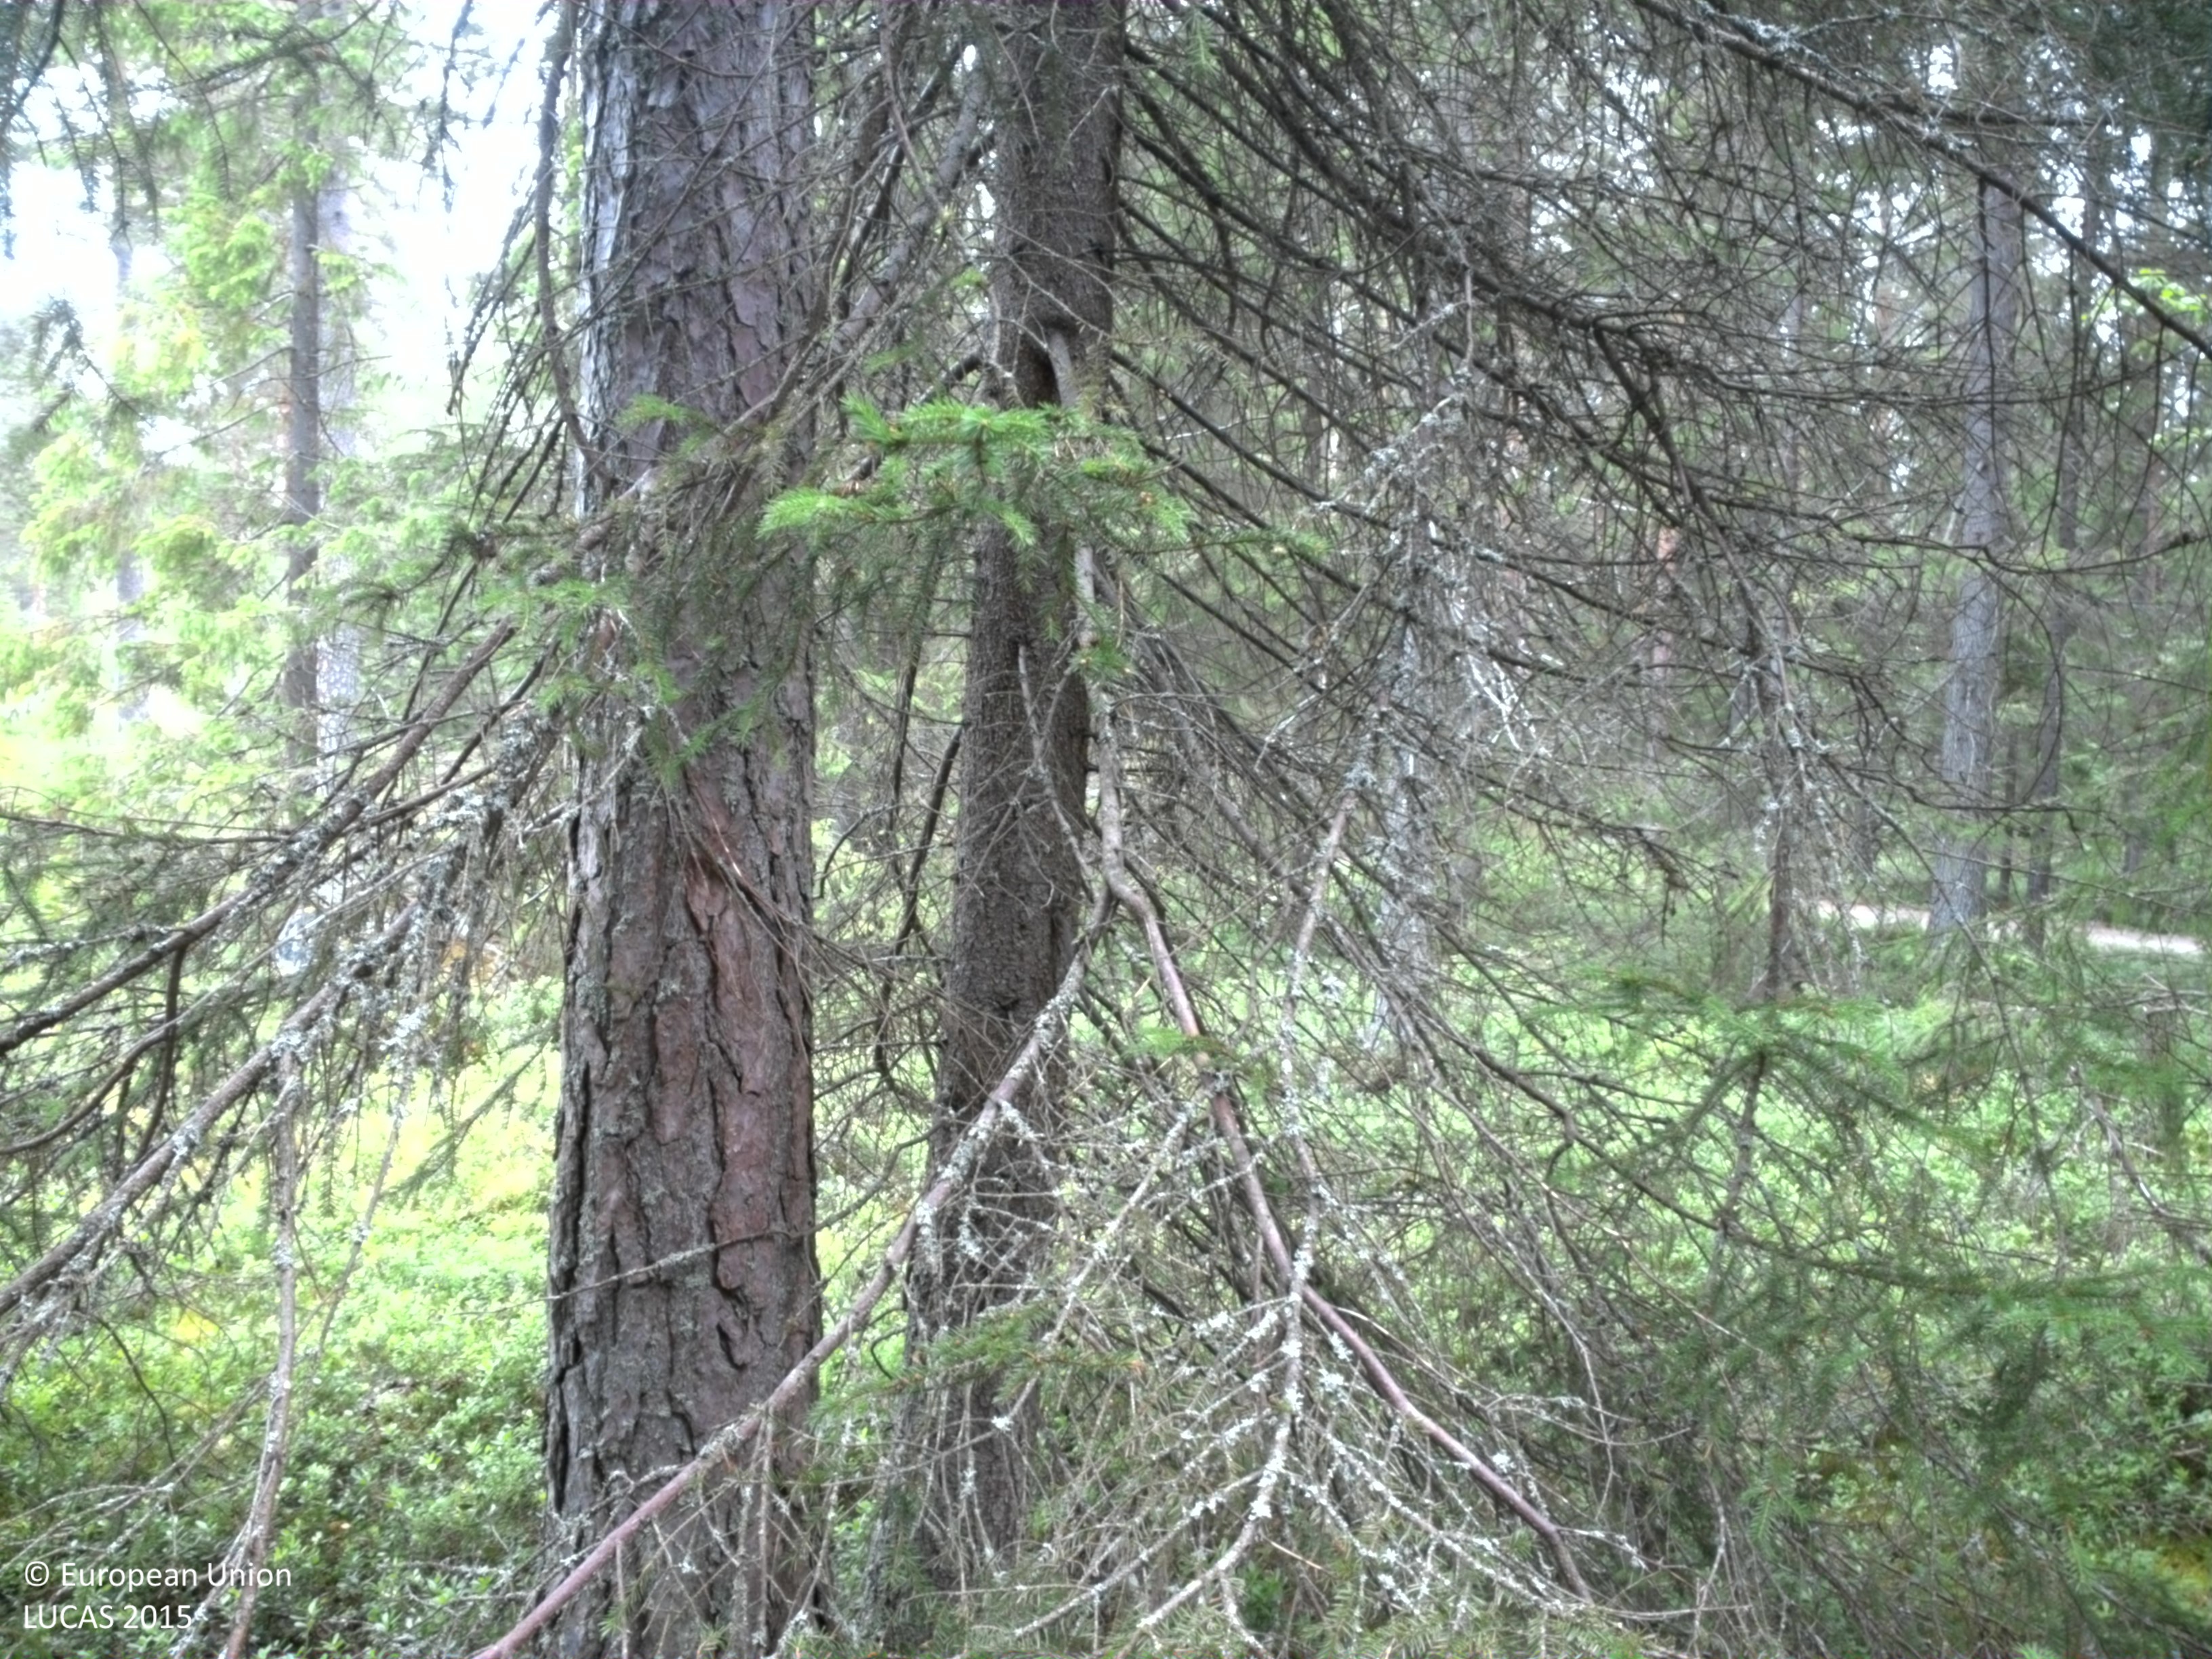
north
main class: Woodland
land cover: Spruce dominated coniferous woodland
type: boreal forest
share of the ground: 50 - 75 %
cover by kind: coniferous forest trees 75 %, shrubs 25 %
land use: Forestry
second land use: Amenities, museums, leisure
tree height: > 5 m
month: July
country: SE
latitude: 64.5949
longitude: 21.3265
